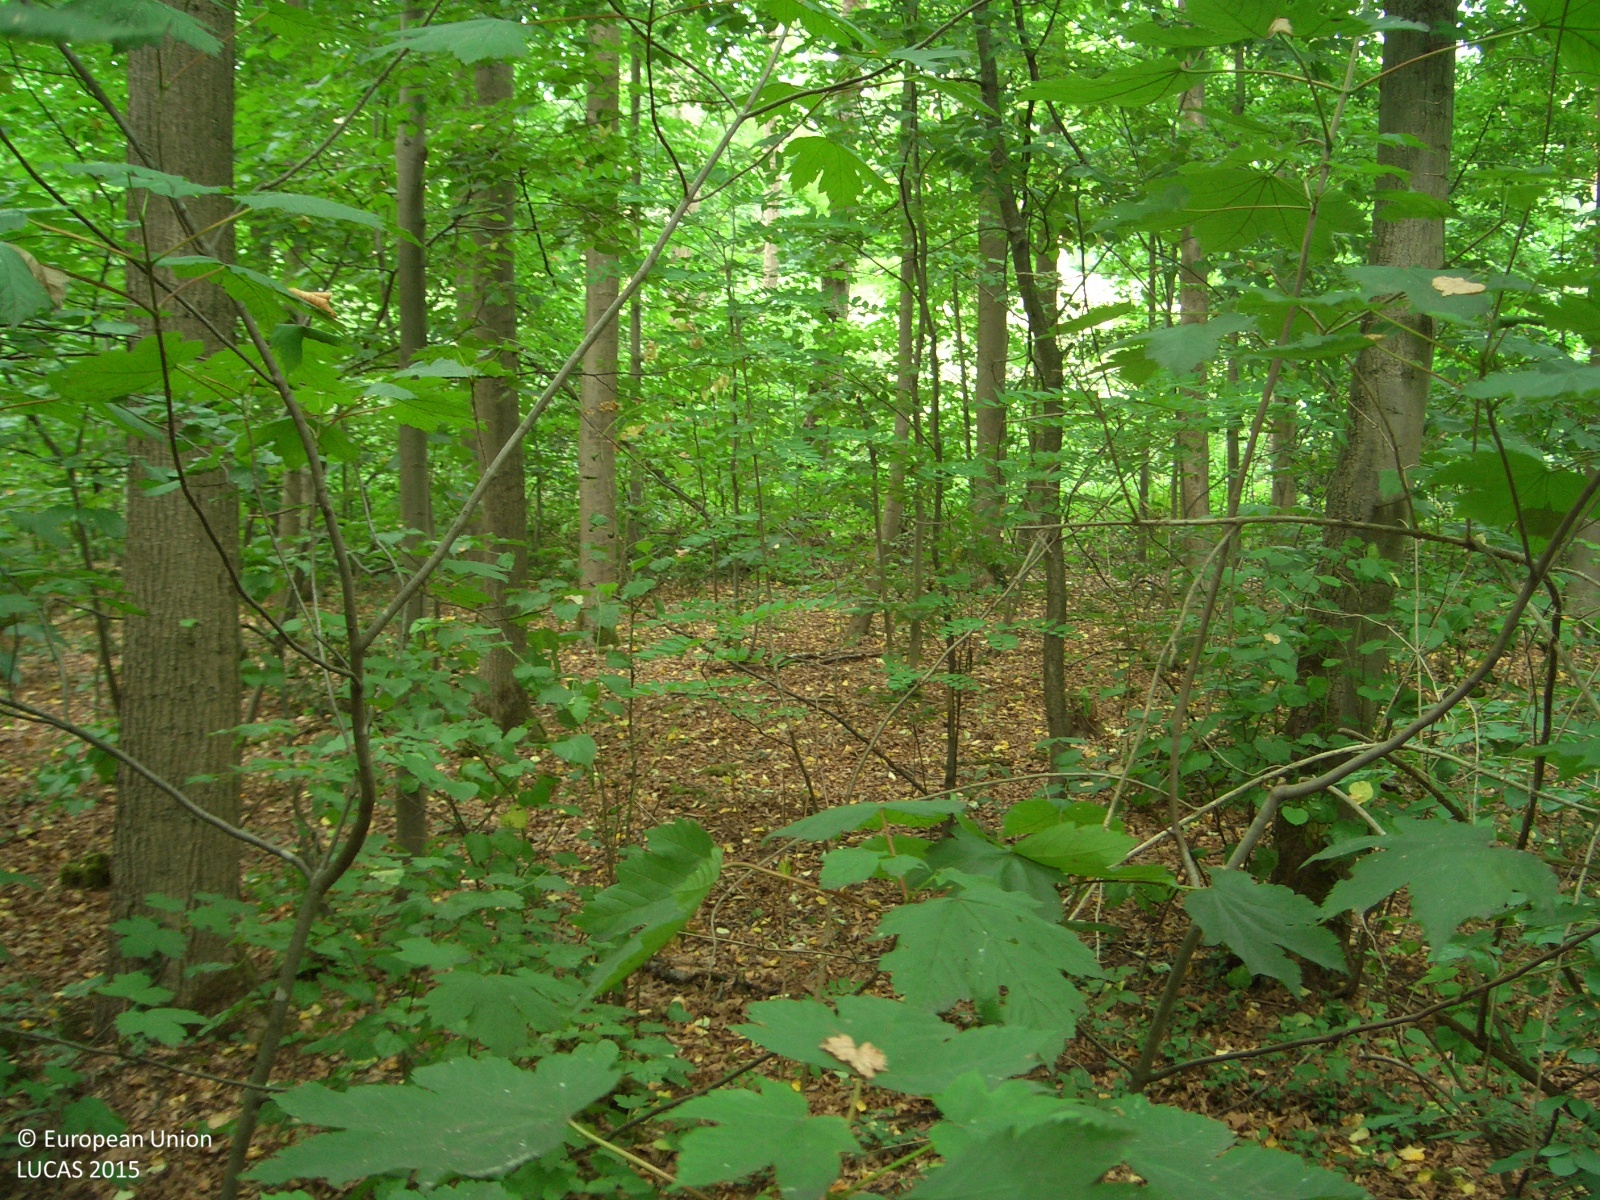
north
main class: Woodland
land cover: Broadleaved woodland
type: mesophytic deciduous forest
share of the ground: > 75 %
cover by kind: broadleaved forest trees 95 %, unconsolidated bare surface 5 %
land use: Forestry
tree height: > 5 m
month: June
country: DE
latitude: 50.9918
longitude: 7.0508
